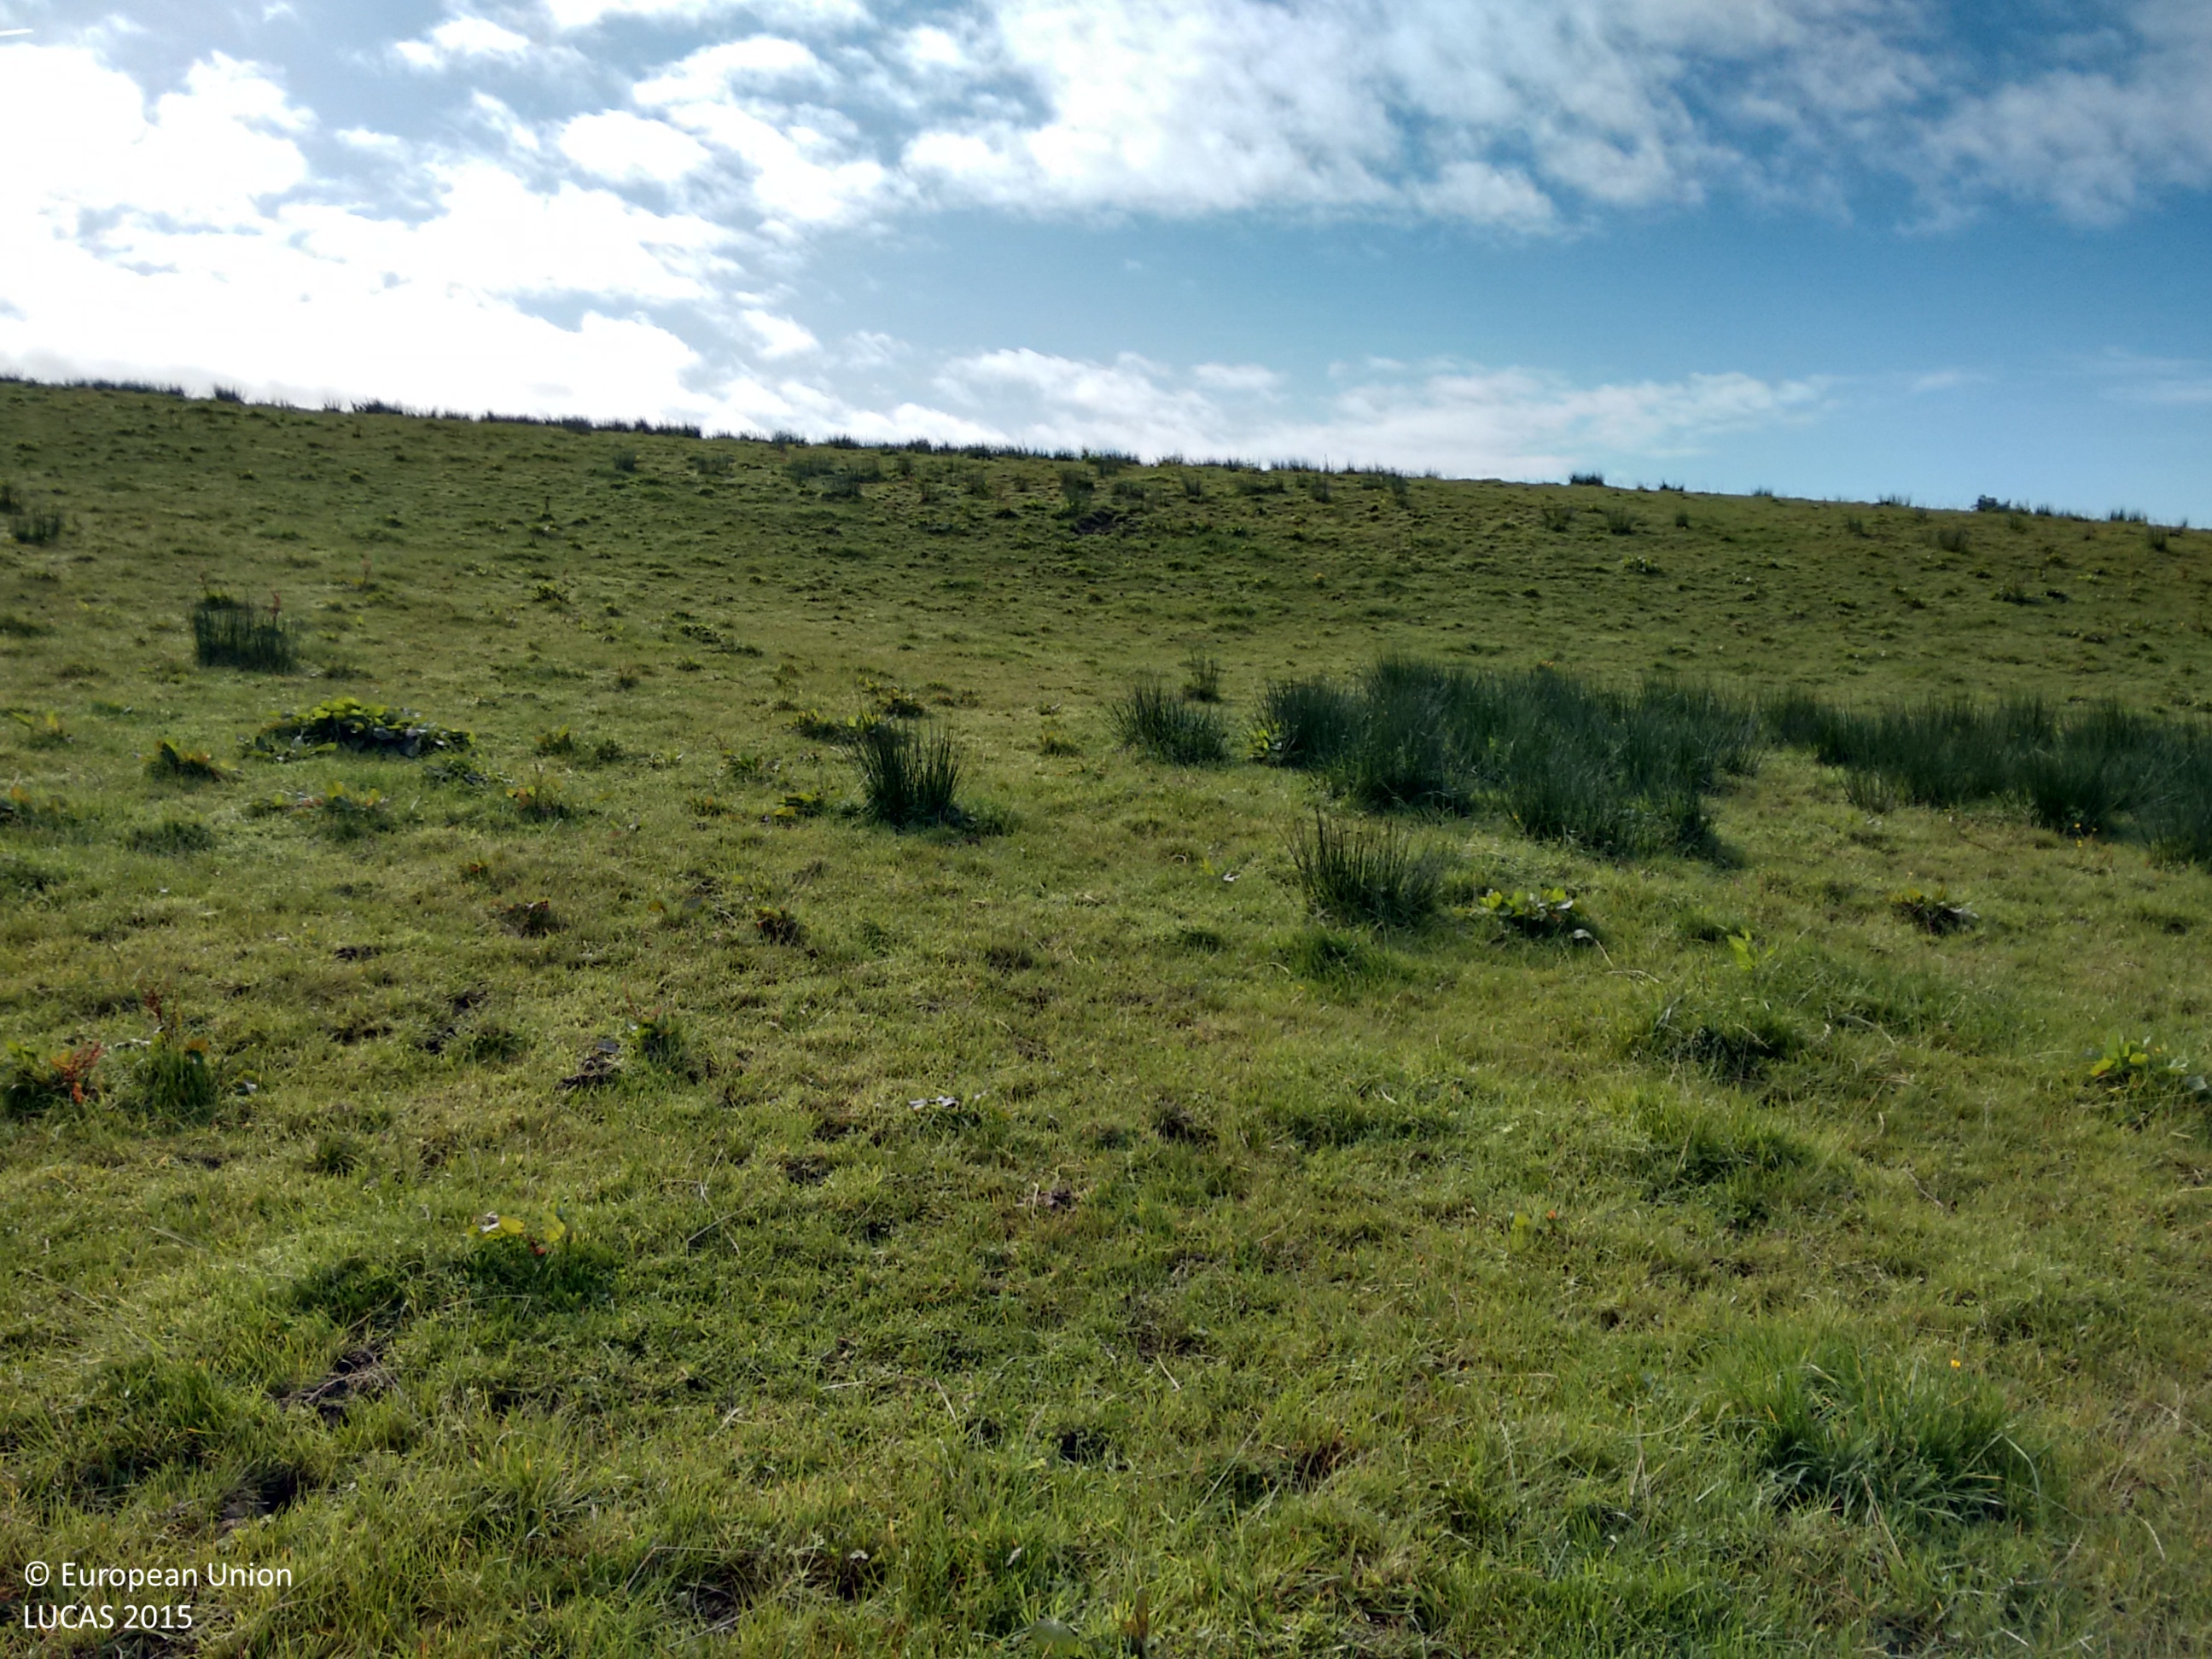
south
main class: Grassland
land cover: Grassland without tree/shrub cover
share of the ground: > 75 %
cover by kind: herbaceous plants 100 %
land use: Agriculture (excluding fallow land and kitchen gardens)
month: September
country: IE
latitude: 54.1340
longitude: -6.8961
